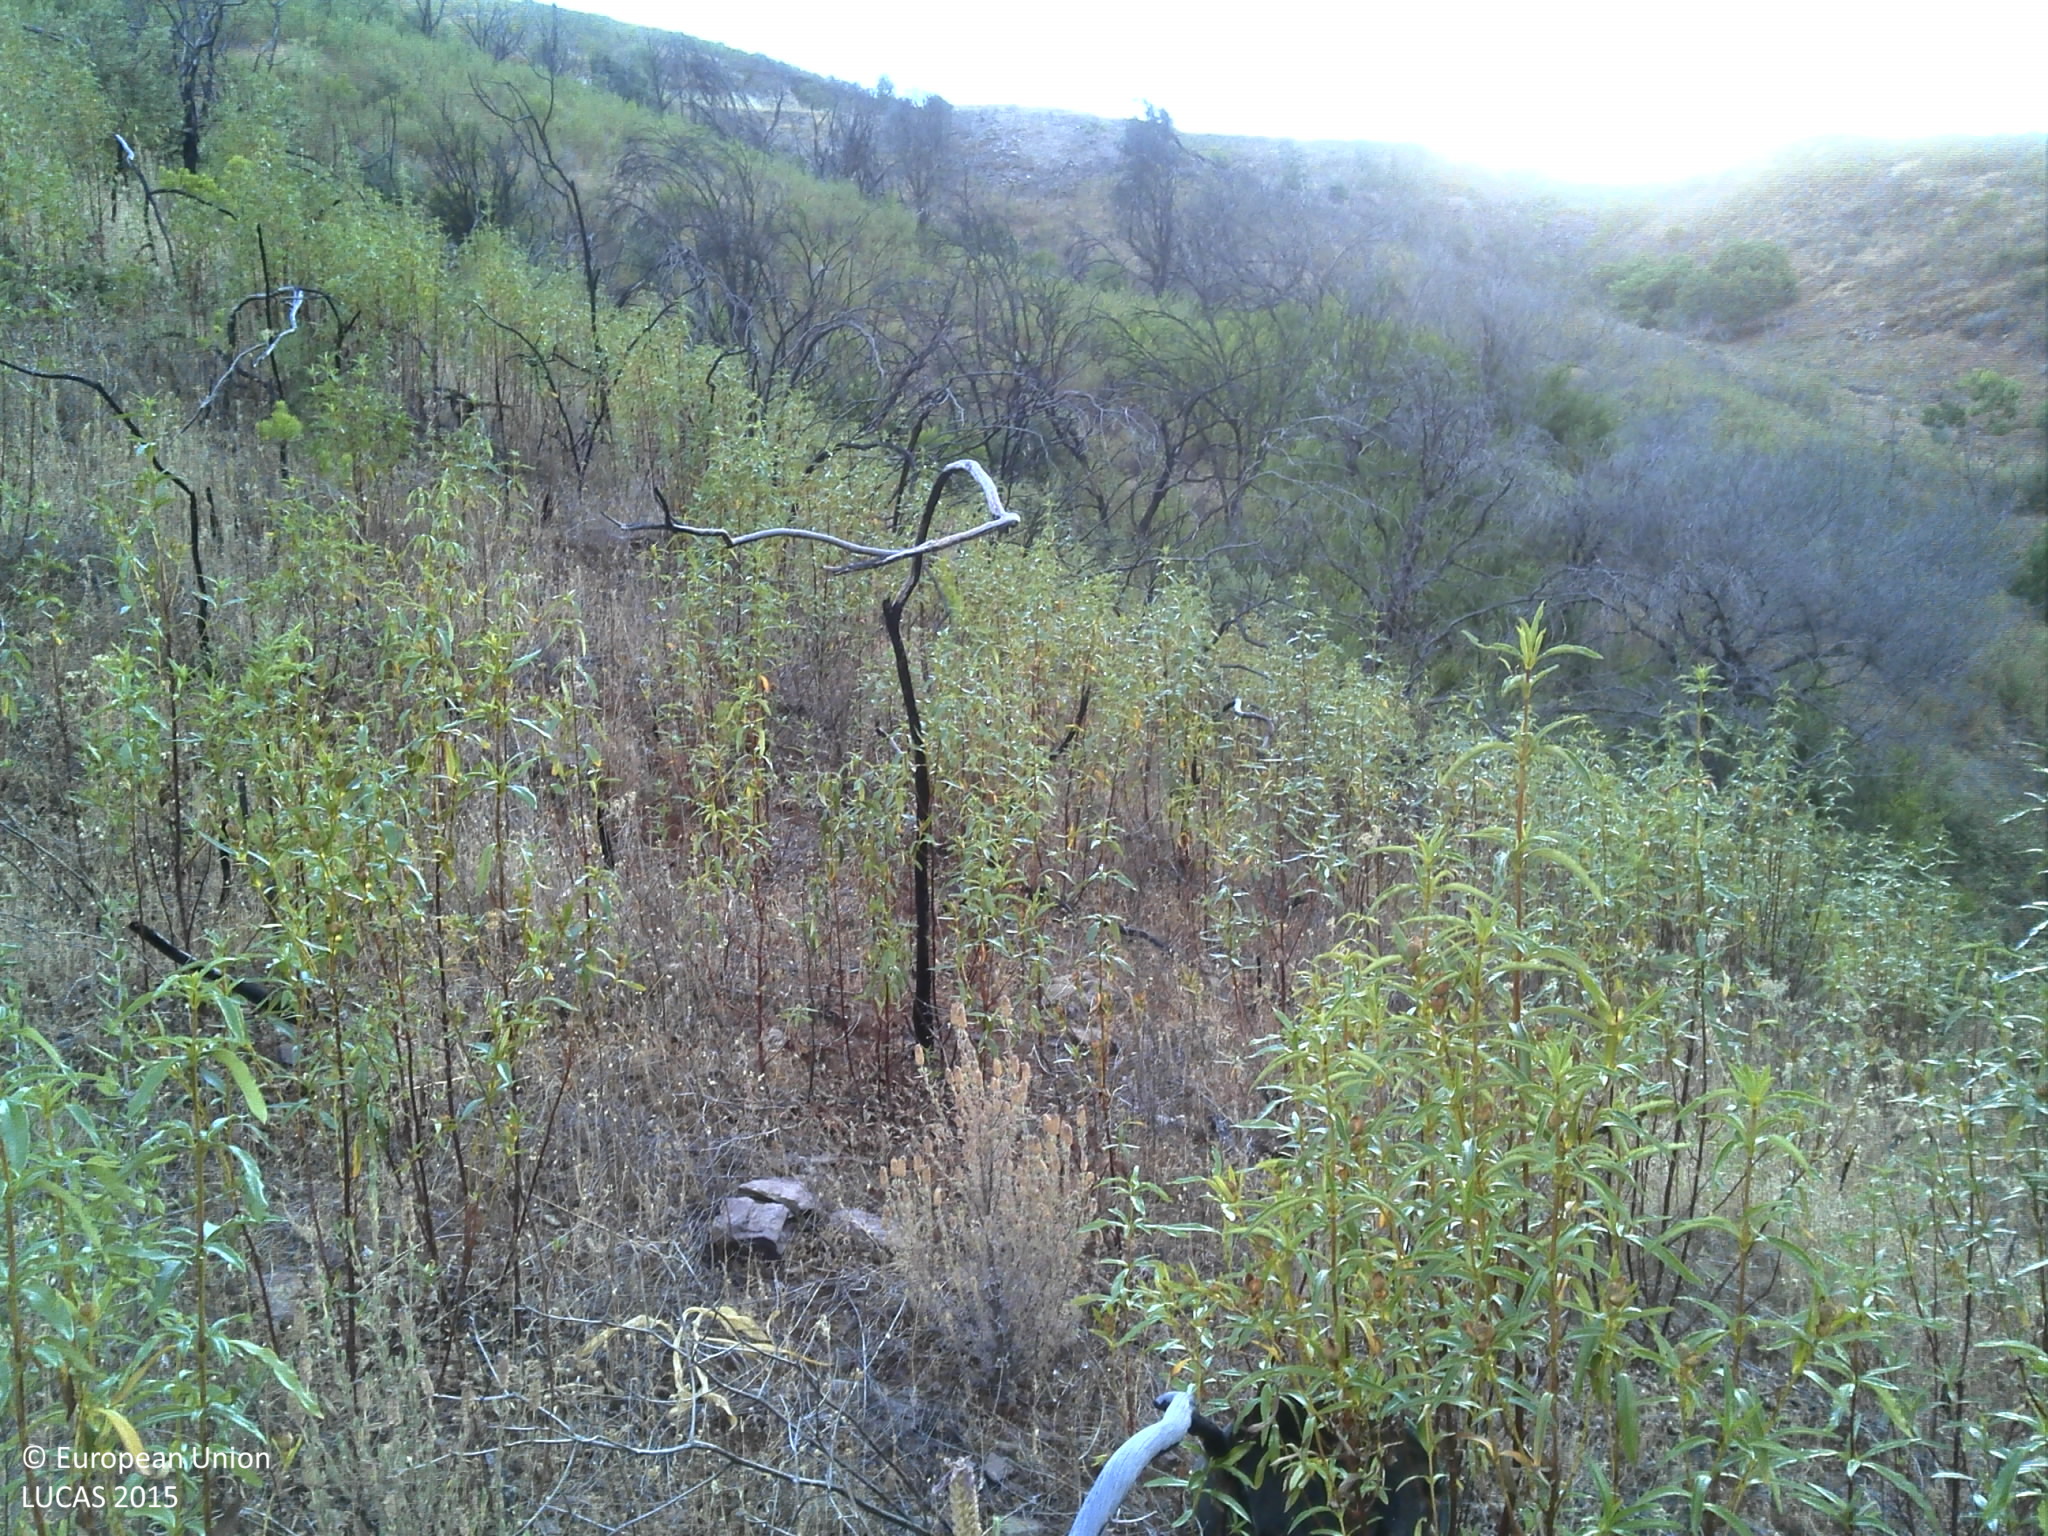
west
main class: Shrubland
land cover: Shrubland without tree cover
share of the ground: 50 - 75 %
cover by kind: shrubs 90 %, herbaceous plants 5 %, unconsolidated bare surface 5 %
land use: Abandoned areas
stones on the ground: < 10 %
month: June
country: PT
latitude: 37.2396
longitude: -7.6946
